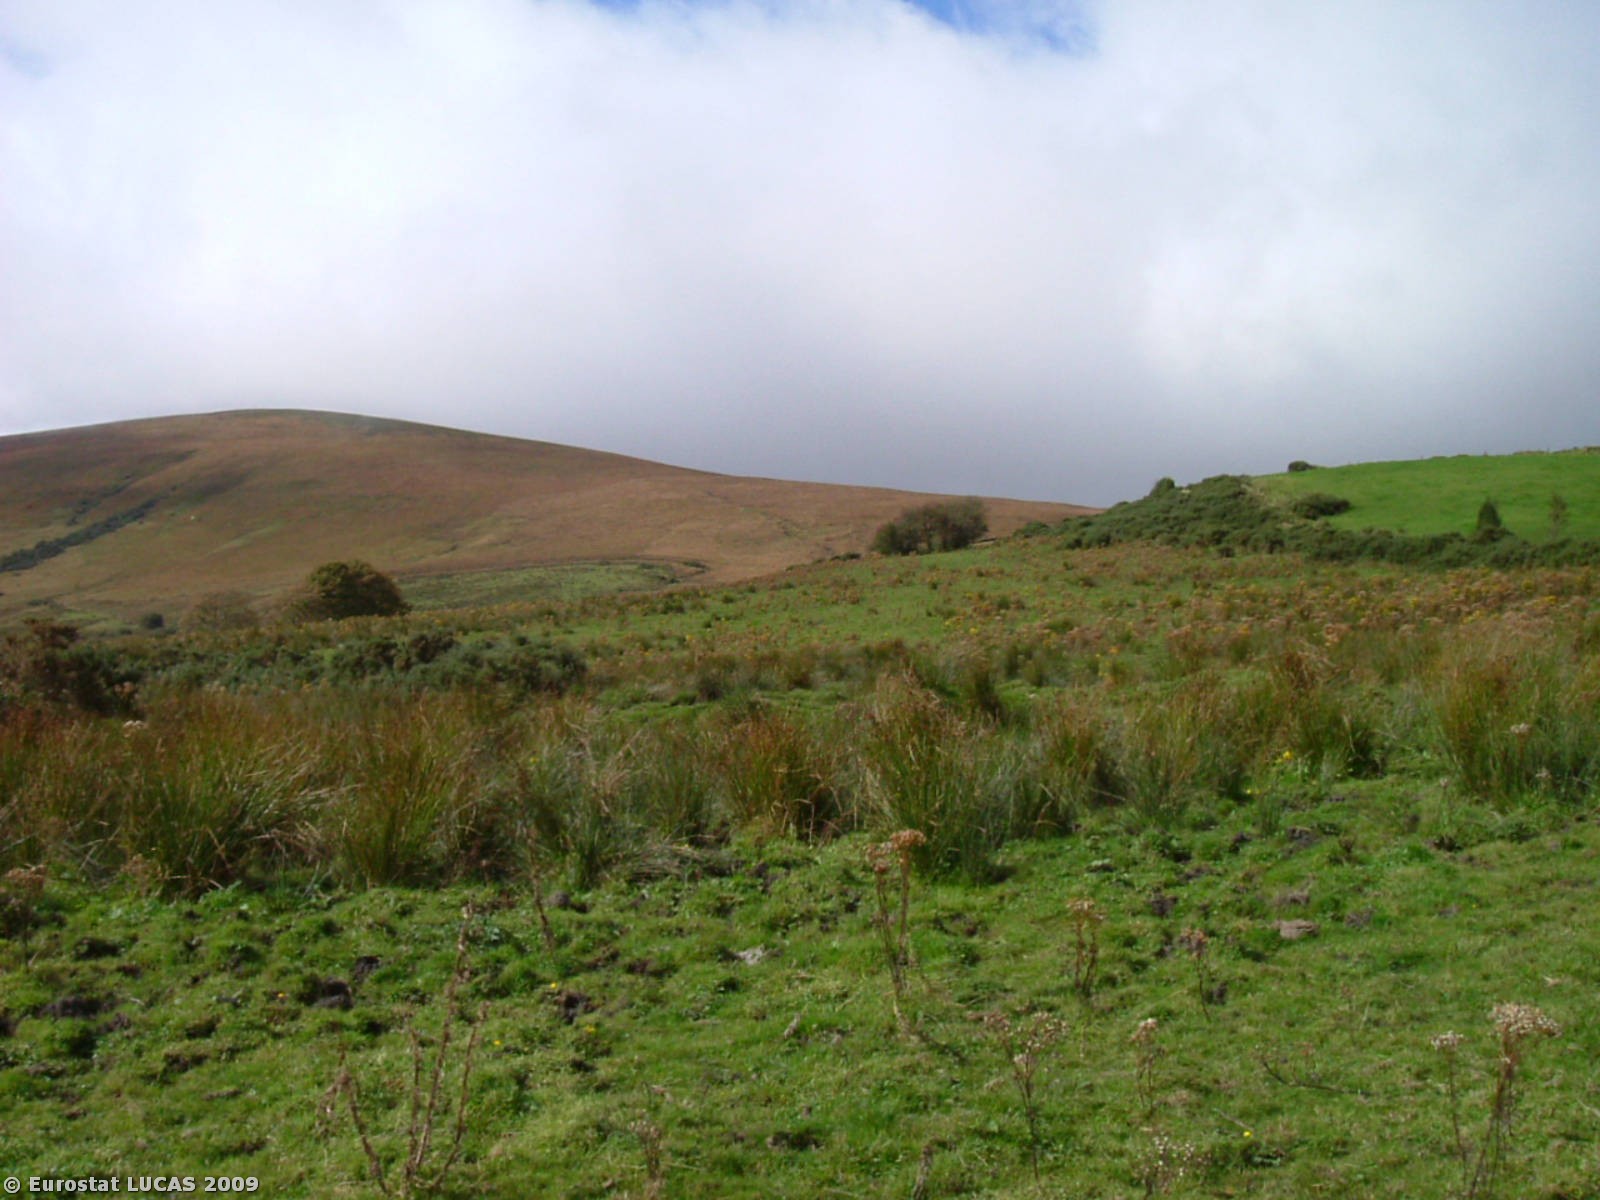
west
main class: Grassland
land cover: Grassland without tree/shrub cover
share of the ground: > 75 %
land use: Agriculture (excluding fallow land and kitchen gardens)
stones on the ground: < 10 %
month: September
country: IE
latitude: 52.7118
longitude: -8.1664
